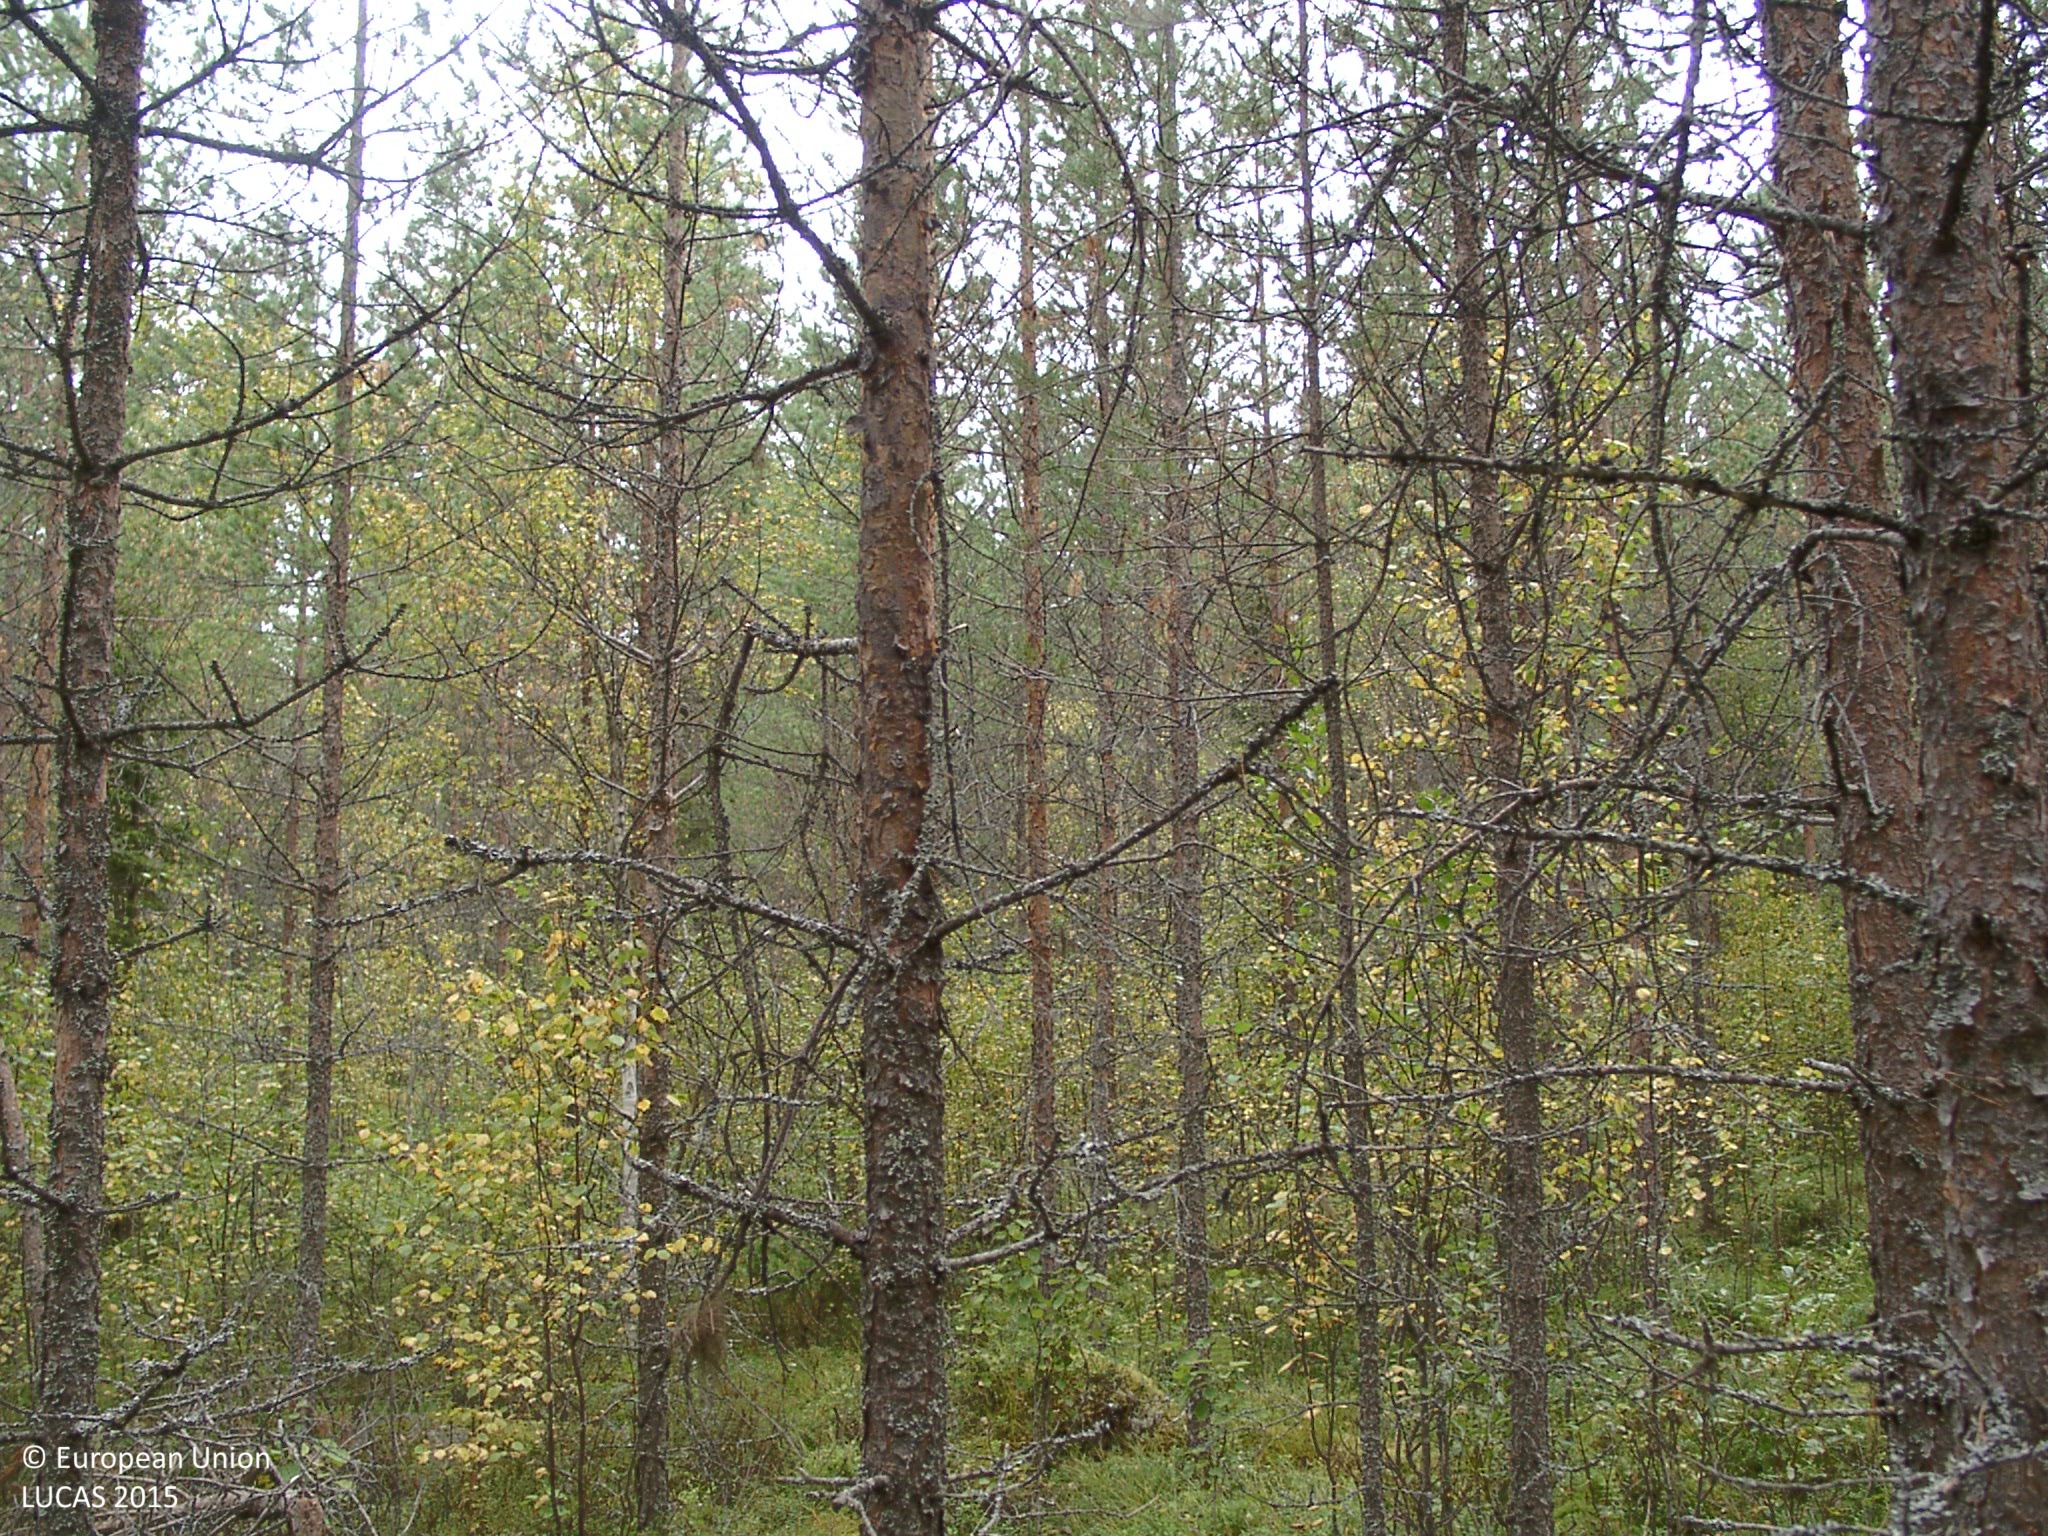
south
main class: Woodland
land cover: Pine dominated coniferous woodland
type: boreal forest
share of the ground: 50 - 75 %
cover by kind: coniferous forest trees 50 %, shrubs 20 %, lichens and mosses 20 %, broadleaved forest trees 10 %
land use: Forestry
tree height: > 5 m
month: September
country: FI
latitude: 62.8706
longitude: 25.3383
